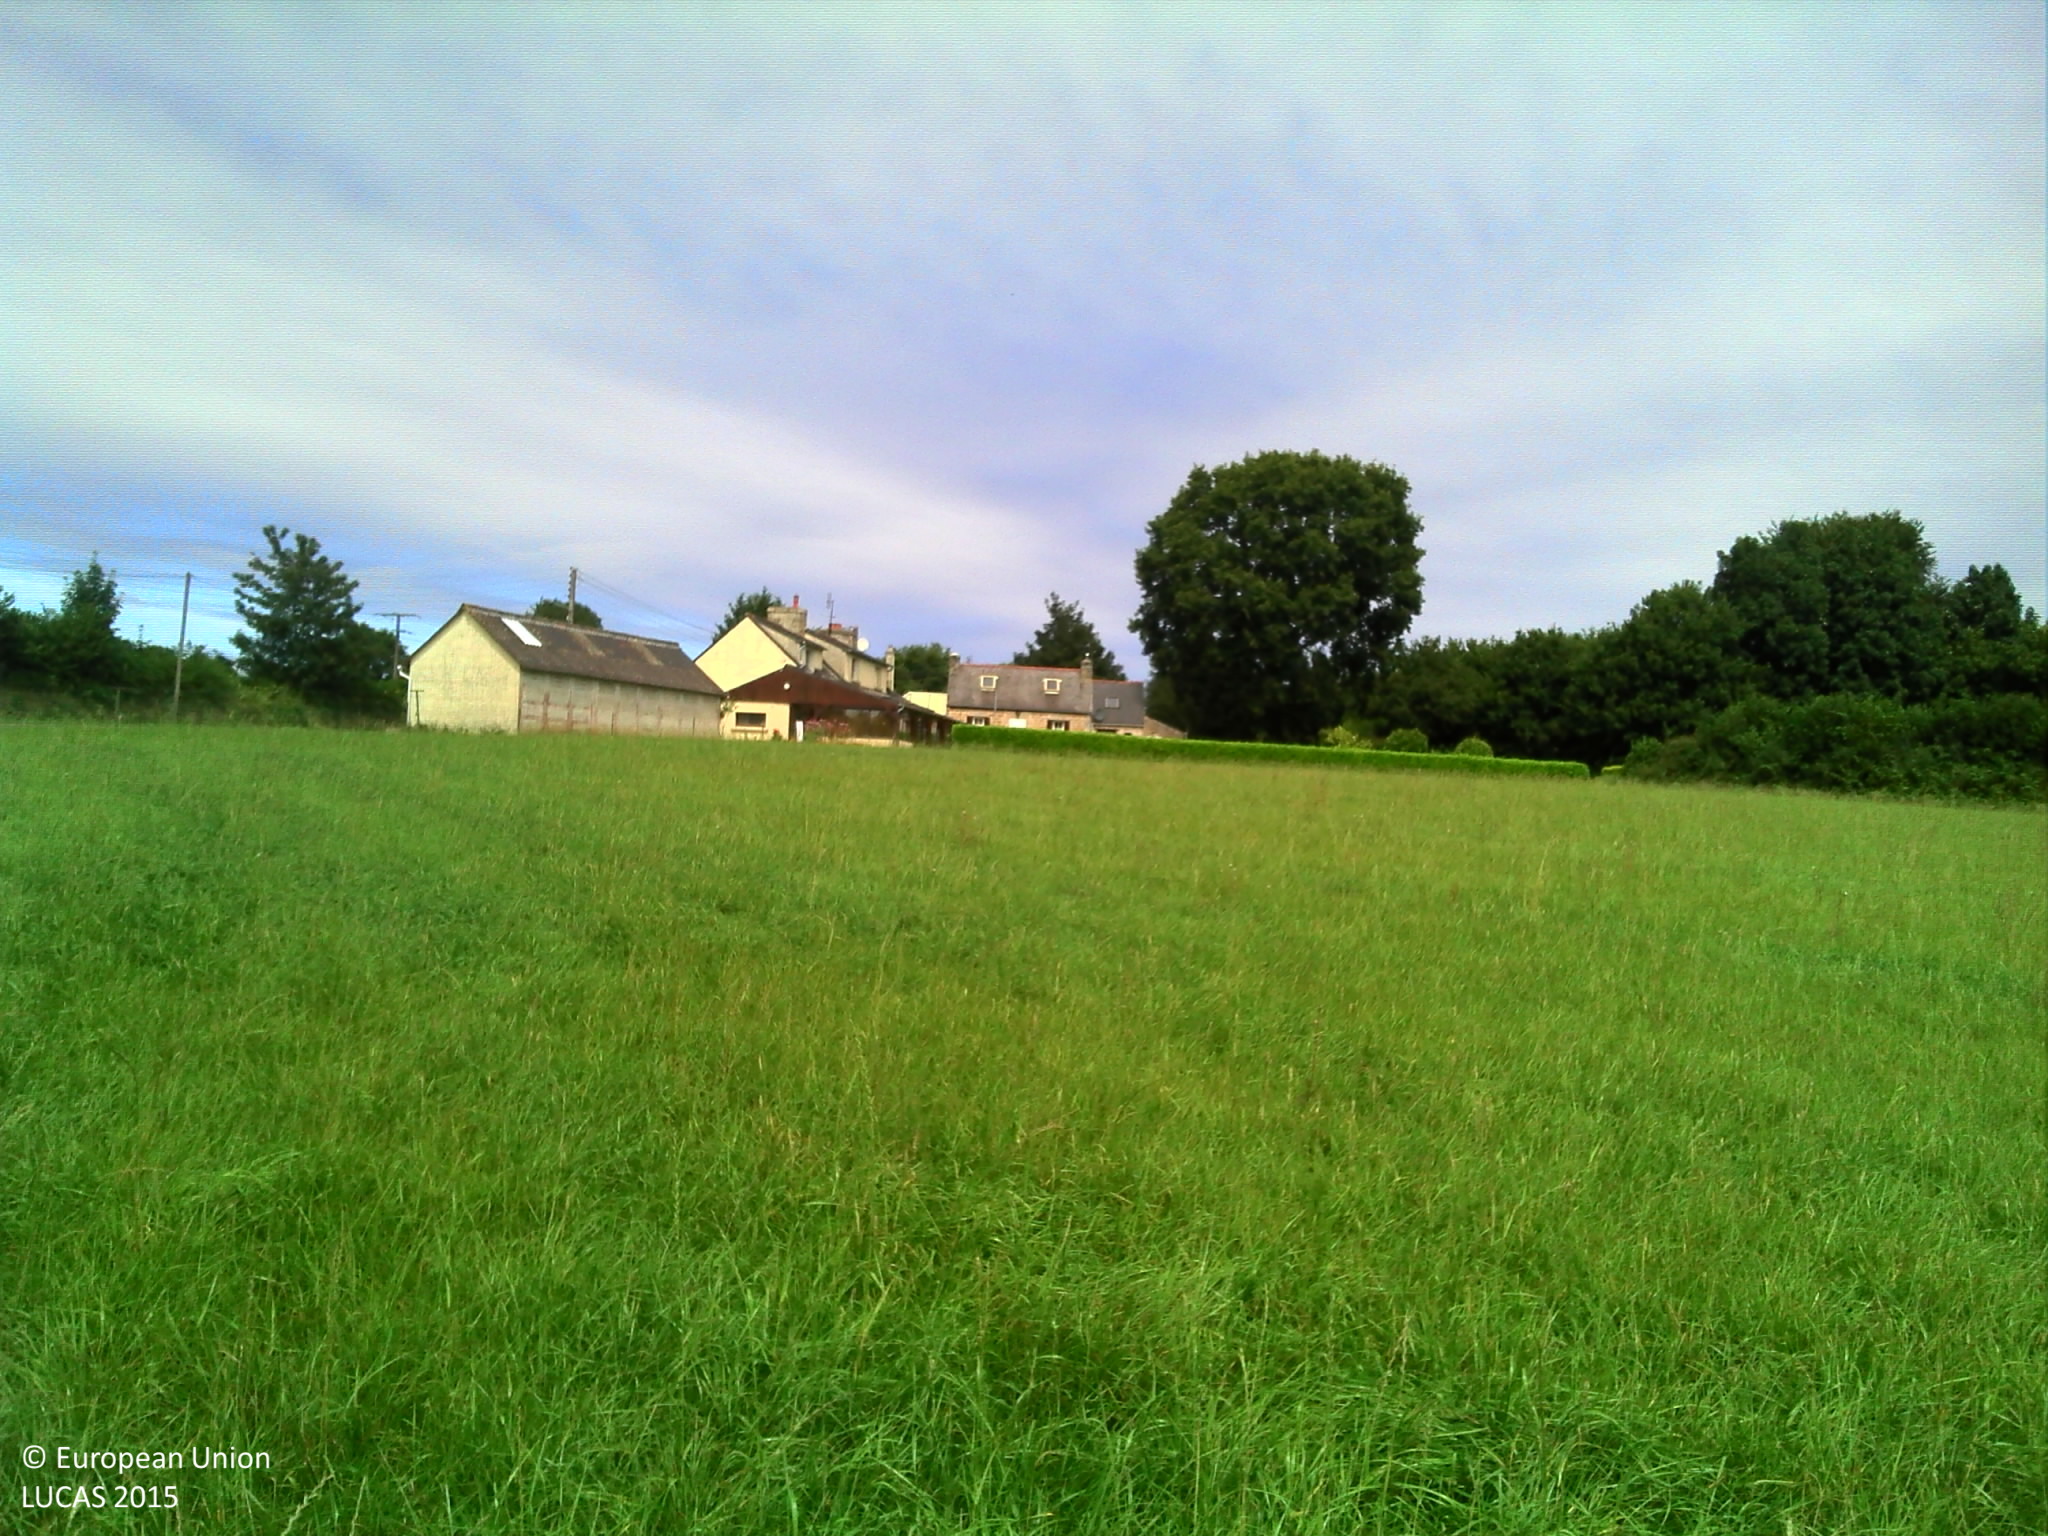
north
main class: Cropland
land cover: Temporary grasslands
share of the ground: > 75 %
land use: Agriculture (excluding fallow land and kitchen gardens)
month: August
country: FR
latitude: 48.5022
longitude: -3.4913
